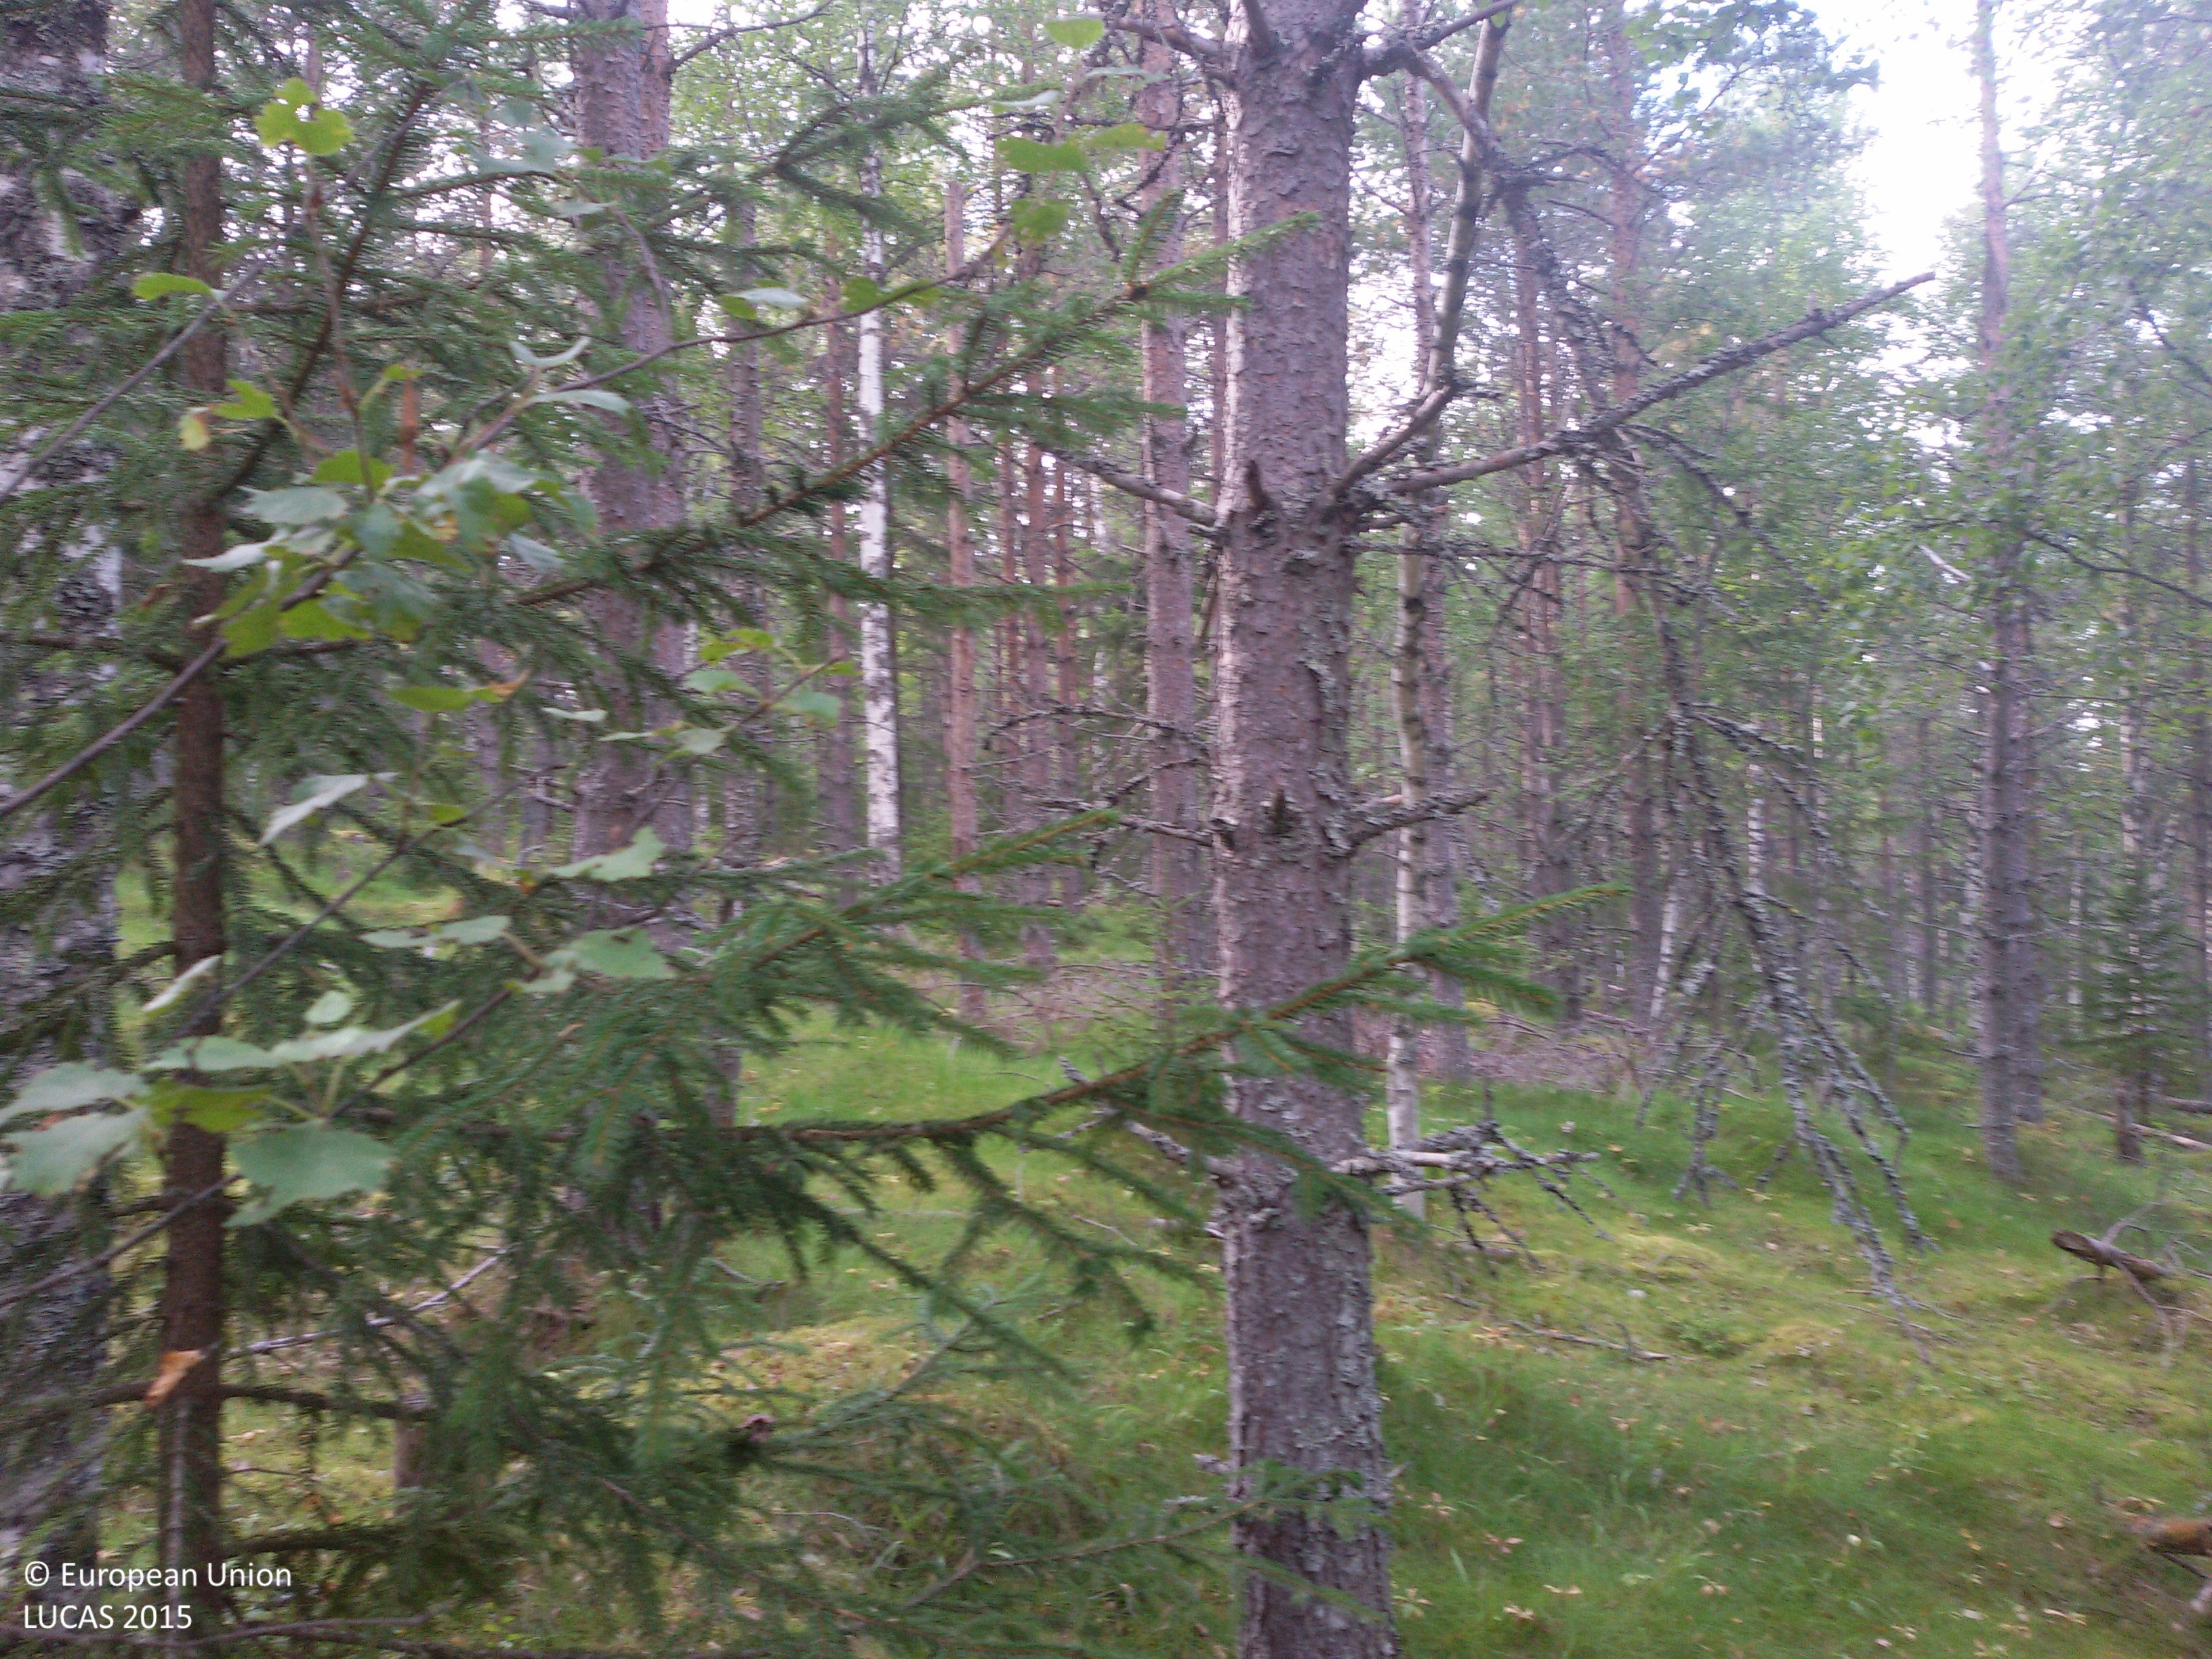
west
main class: Woodland
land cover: Pine dominated mixed woodland
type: boreal forest
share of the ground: > 75 %
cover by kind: coniferous forest trees 50 %, broadleaved forest trees 25 %, herbaceous plants 15 %, lichens and mosses 10 %
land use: Forestry
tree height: > 5 m
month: August
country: SE
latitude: 60.8640
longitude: 16.0442
